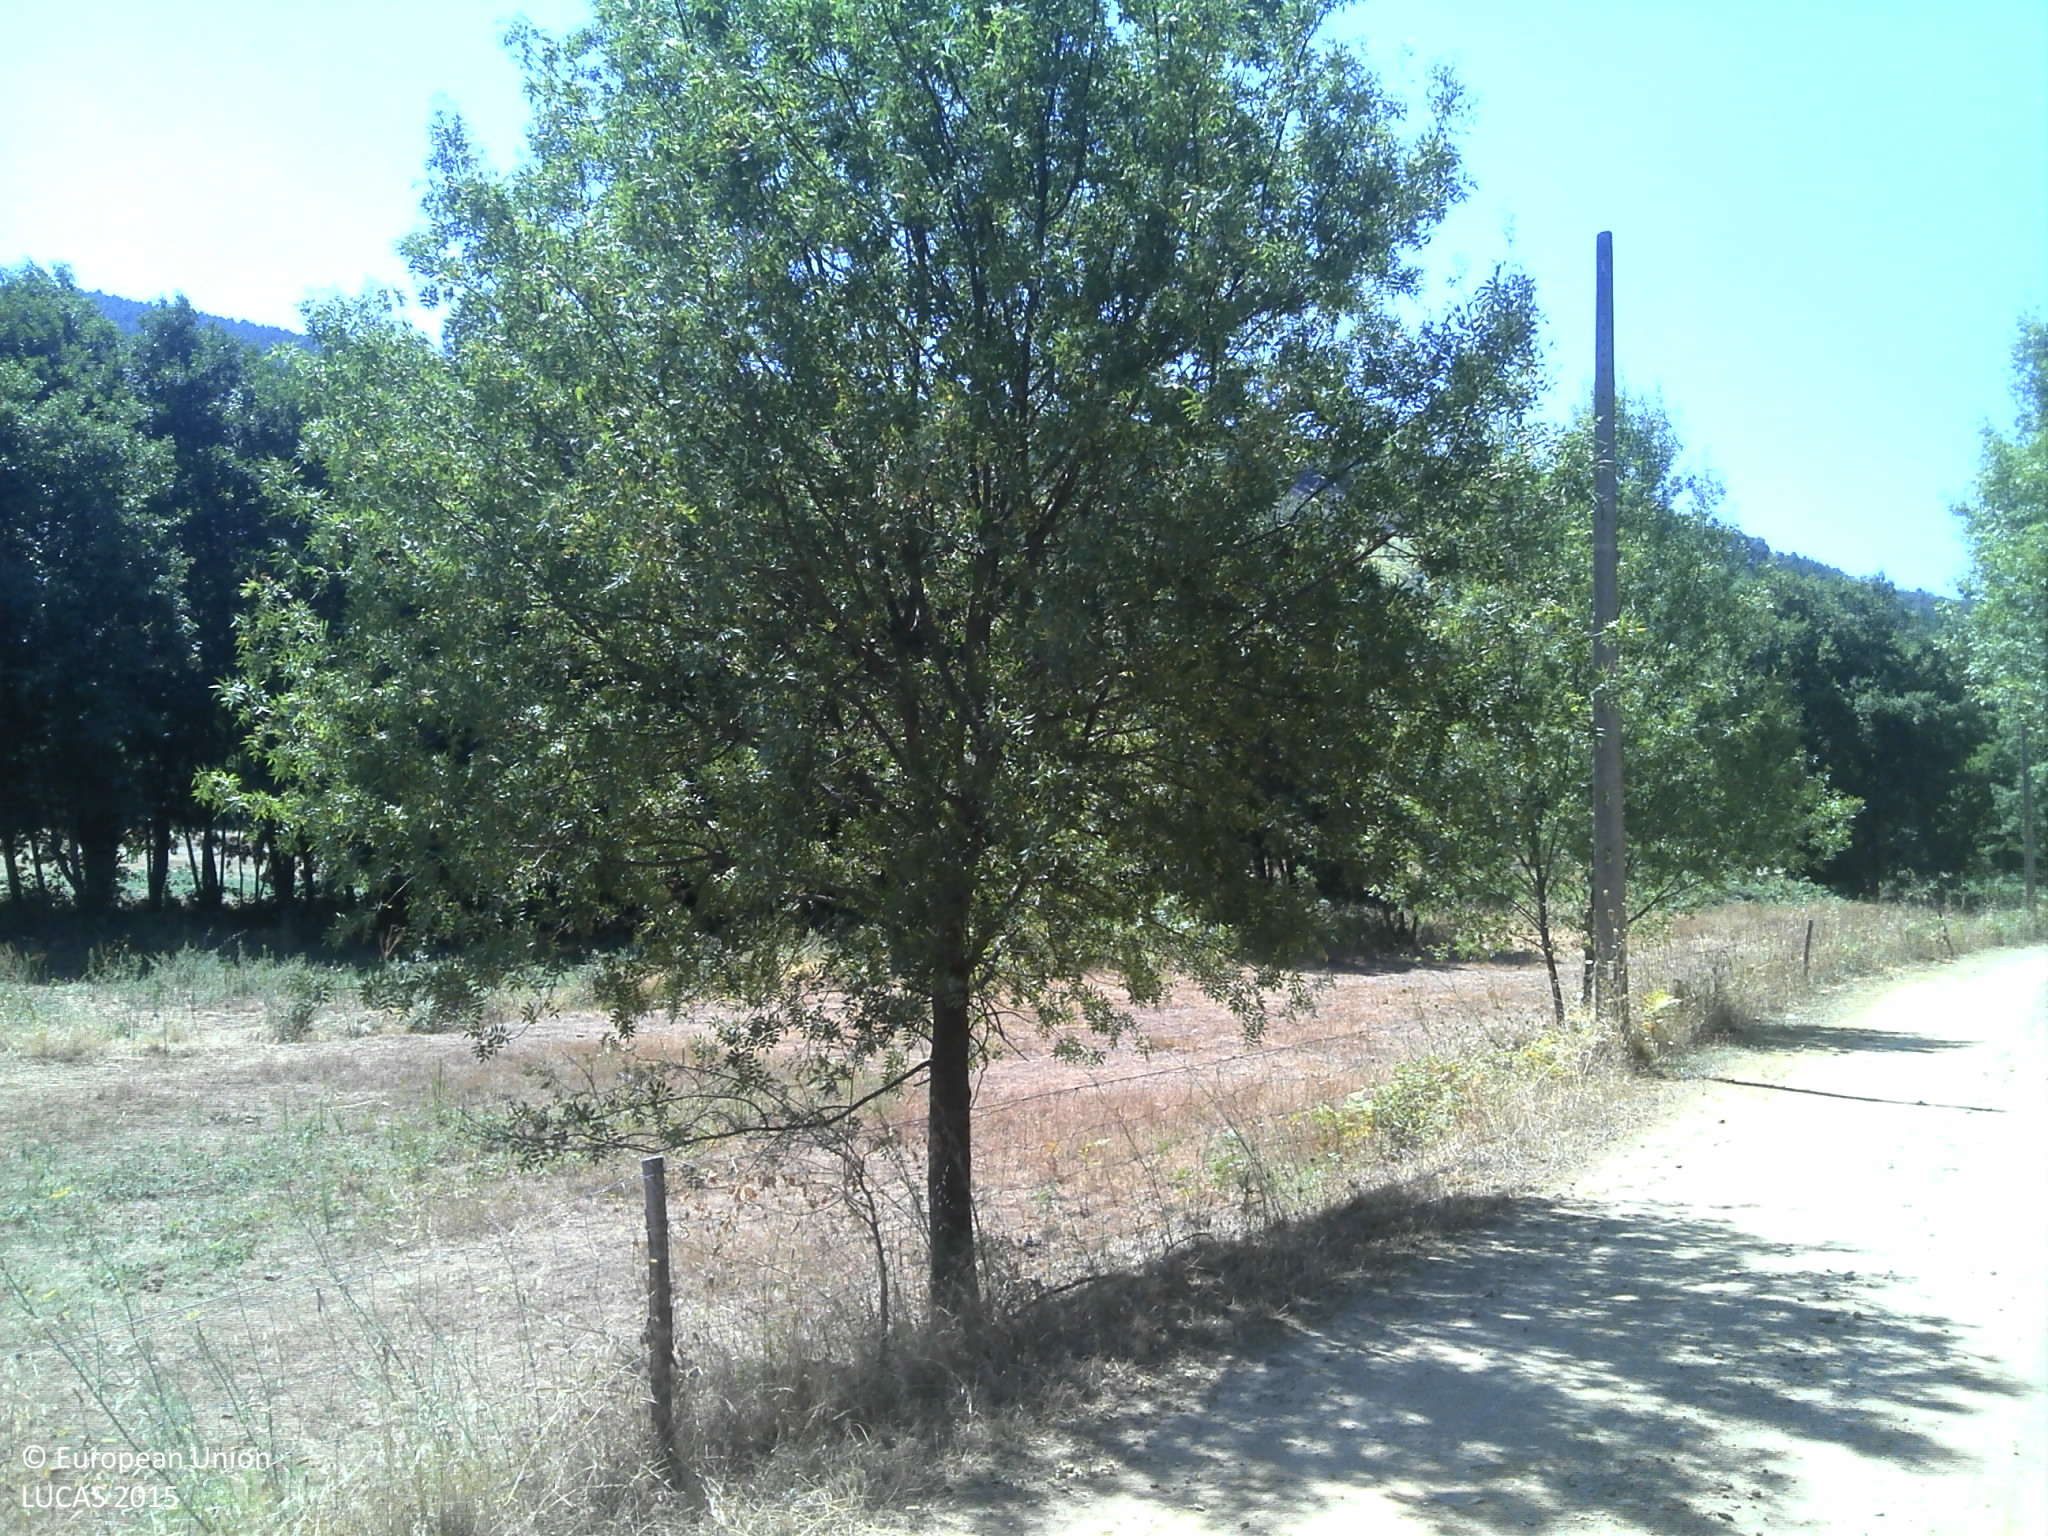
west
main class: Woodland
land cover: Pine dominated coniferous woodland
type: coniferous forest of the mediterranean region
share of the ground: 25 - 50 %
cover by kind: coniferous forest trees 50 %, shrubs 35 %, unconsolidated bare surface 10 %
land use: Forestry
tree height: > 5 m
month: July
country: PT
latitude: 40.3983
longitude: -7.3907
